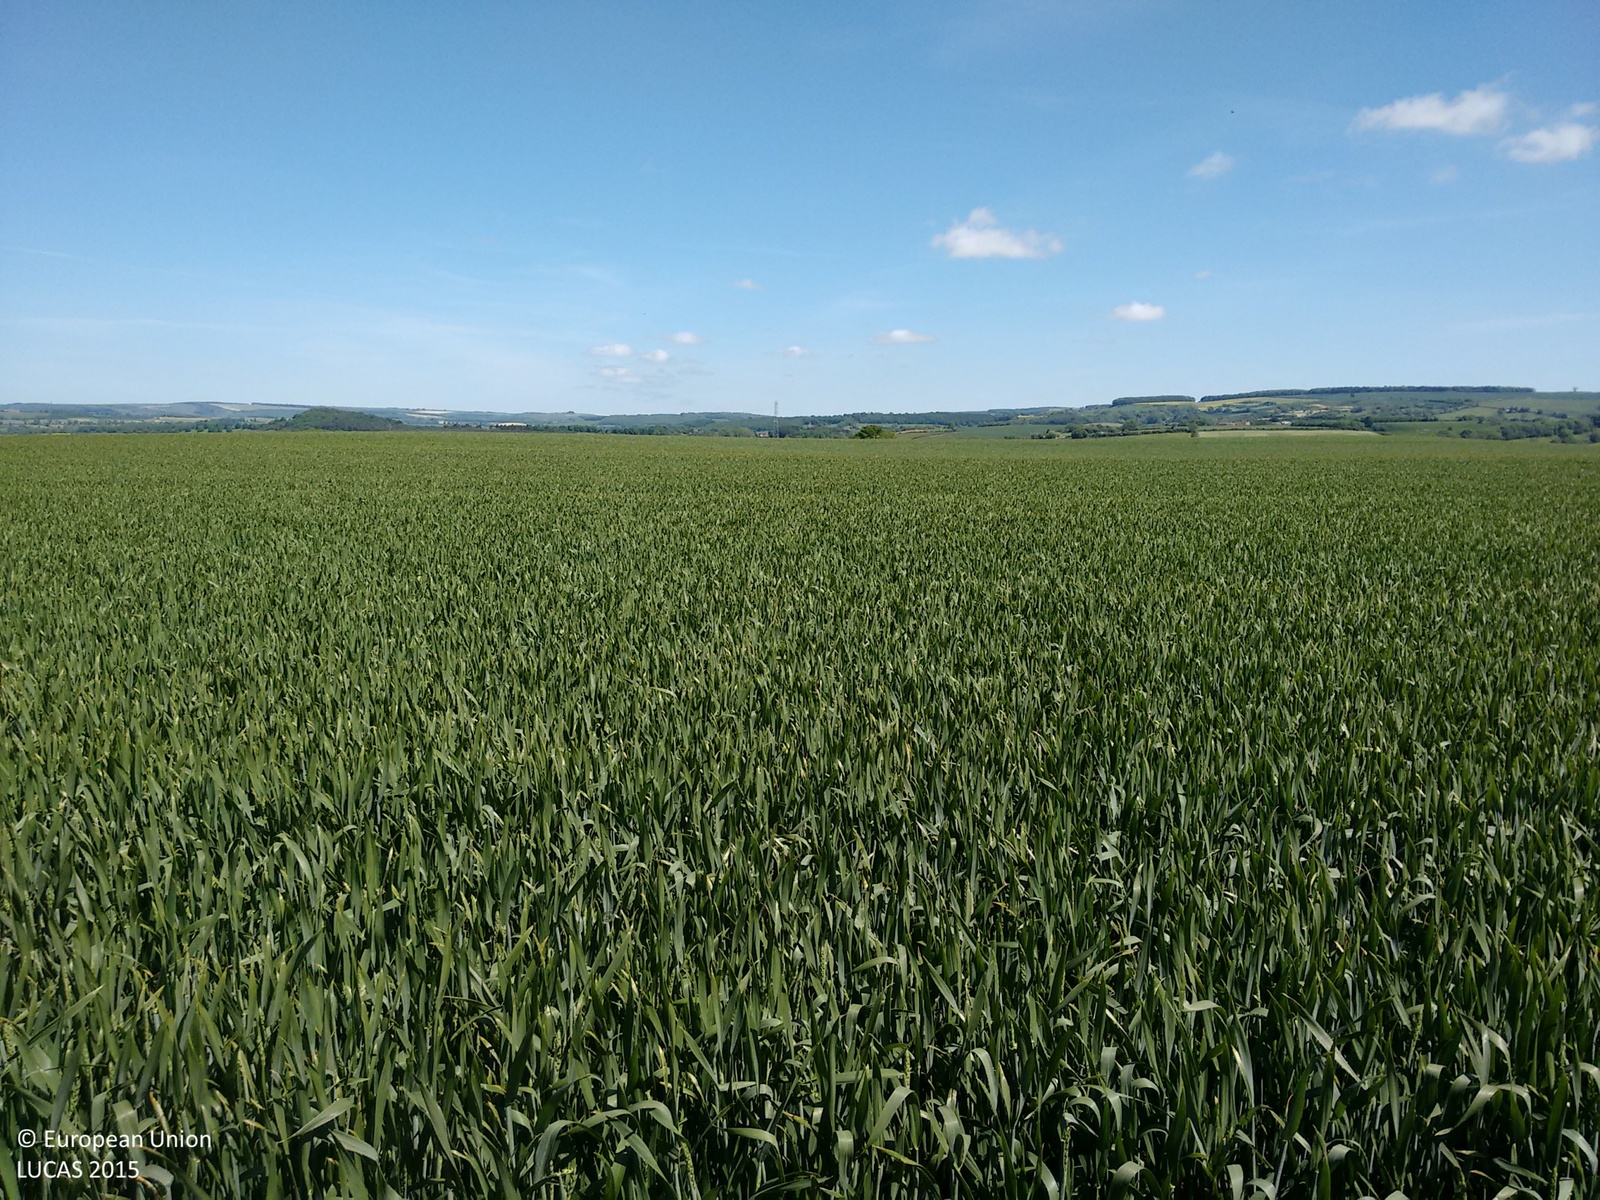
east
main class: Cropland
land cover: Common wheat
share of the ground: > 75 %
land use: Agriculture (excluding fallow land and kitchen gardens)
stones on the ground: < 10 %
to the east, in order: Common wheat
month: June
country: GB
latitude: 54.0747
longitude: -0.8457
